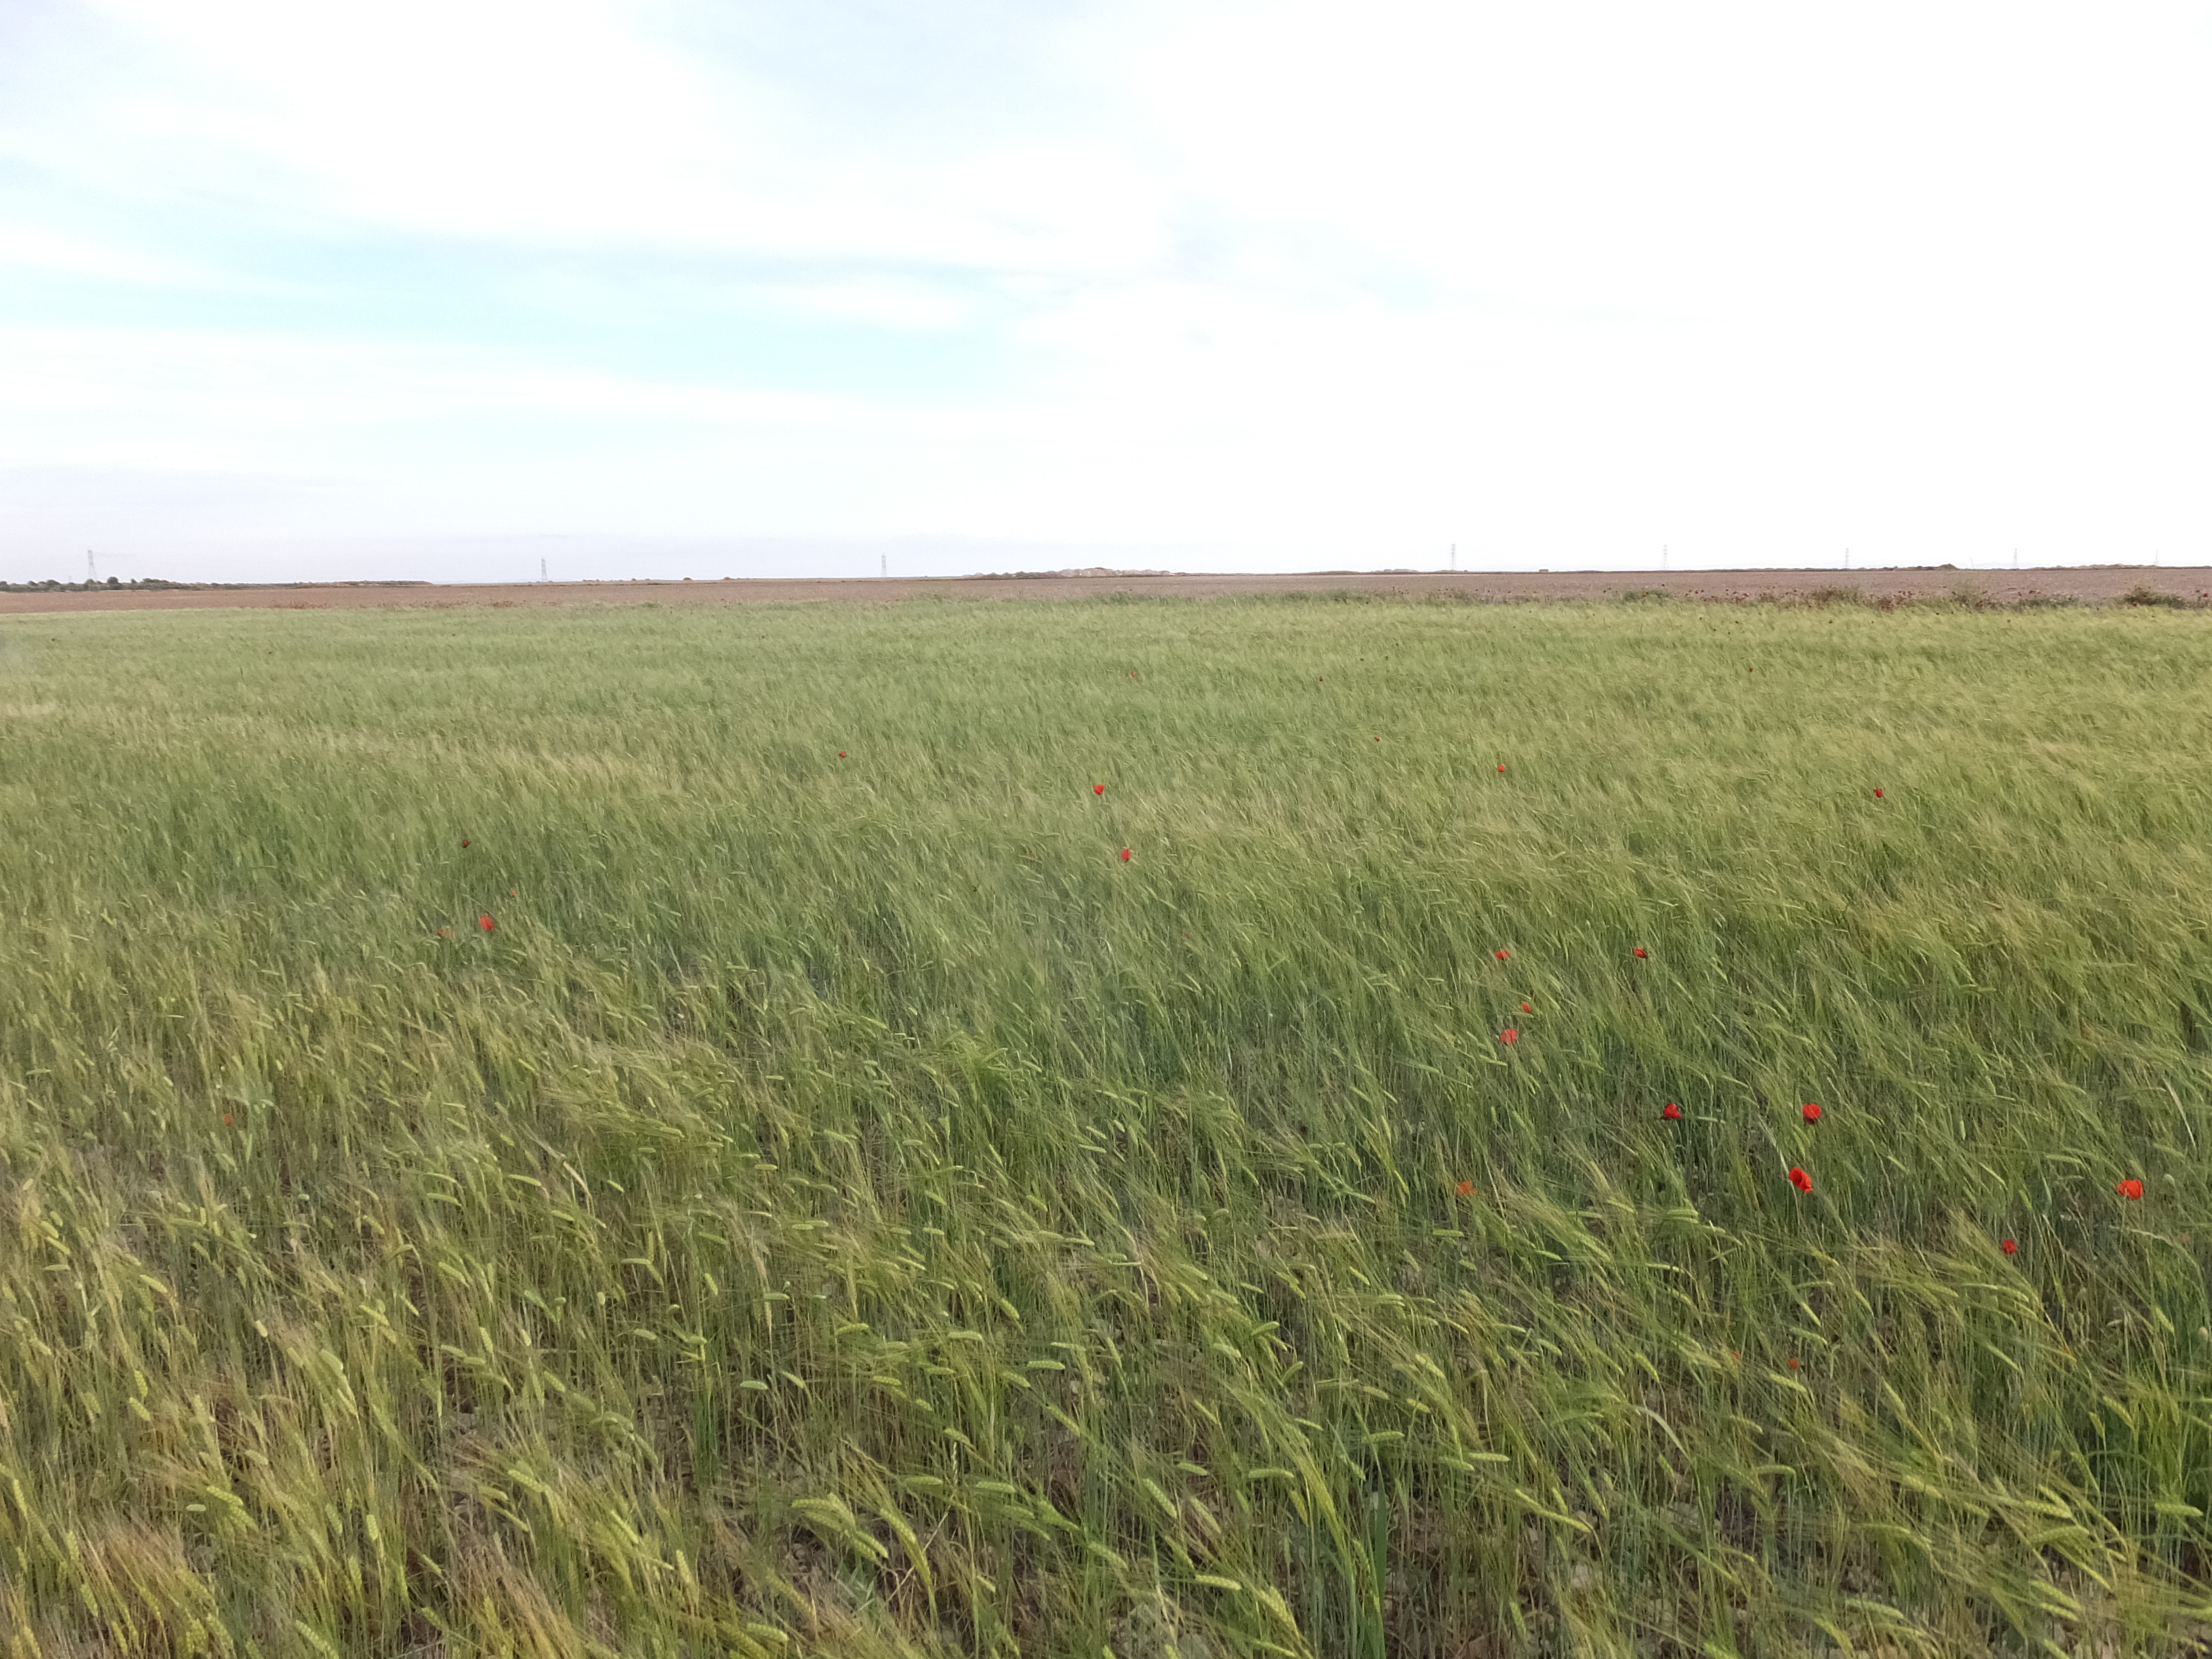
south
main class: Cropland
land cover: Barley
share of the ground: > 75 %
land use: Agriculture (excluding fallow land and kitchen gardens)
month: May
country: ES
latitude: 41.4104
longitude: -0.1955
